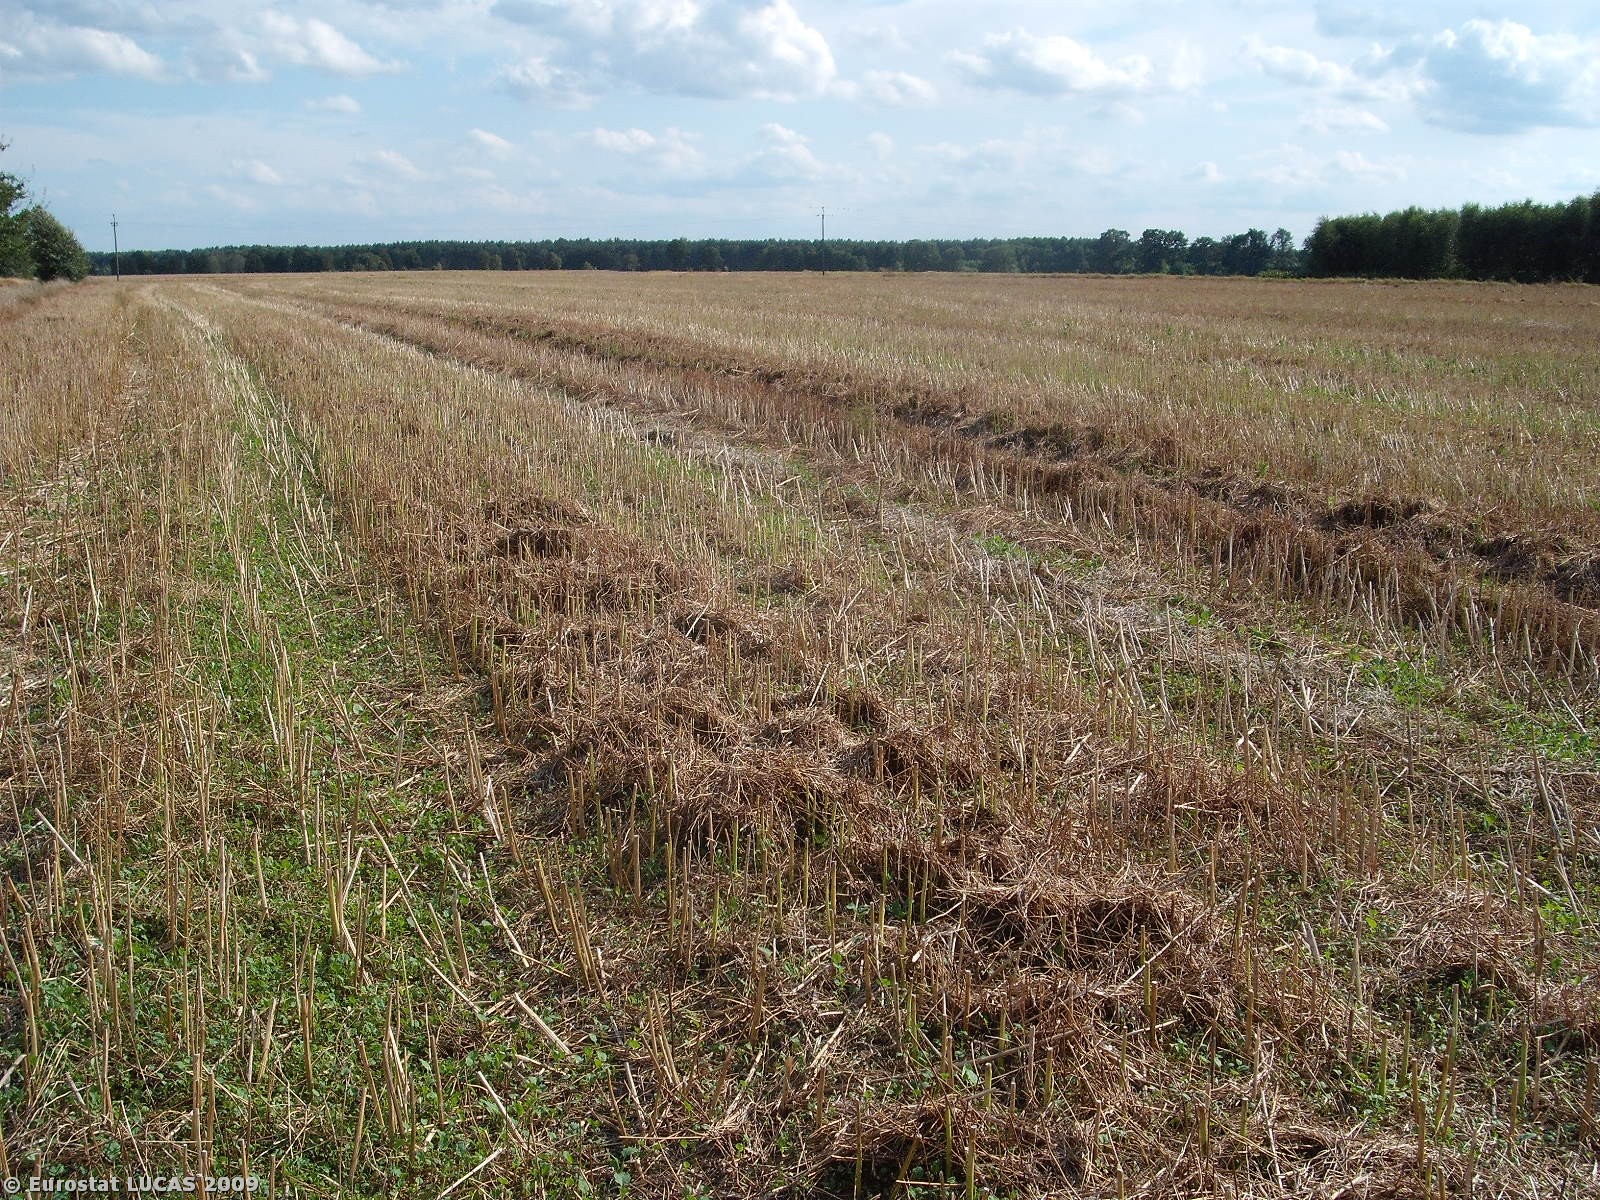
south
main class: Cropland
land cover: Other fibre and oleaginous crops
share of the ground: < 10 %
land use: Agriculture (excluding fallow land and kitchen gardens)
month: August
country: PL
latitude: 51.8408
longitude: 21.6208
